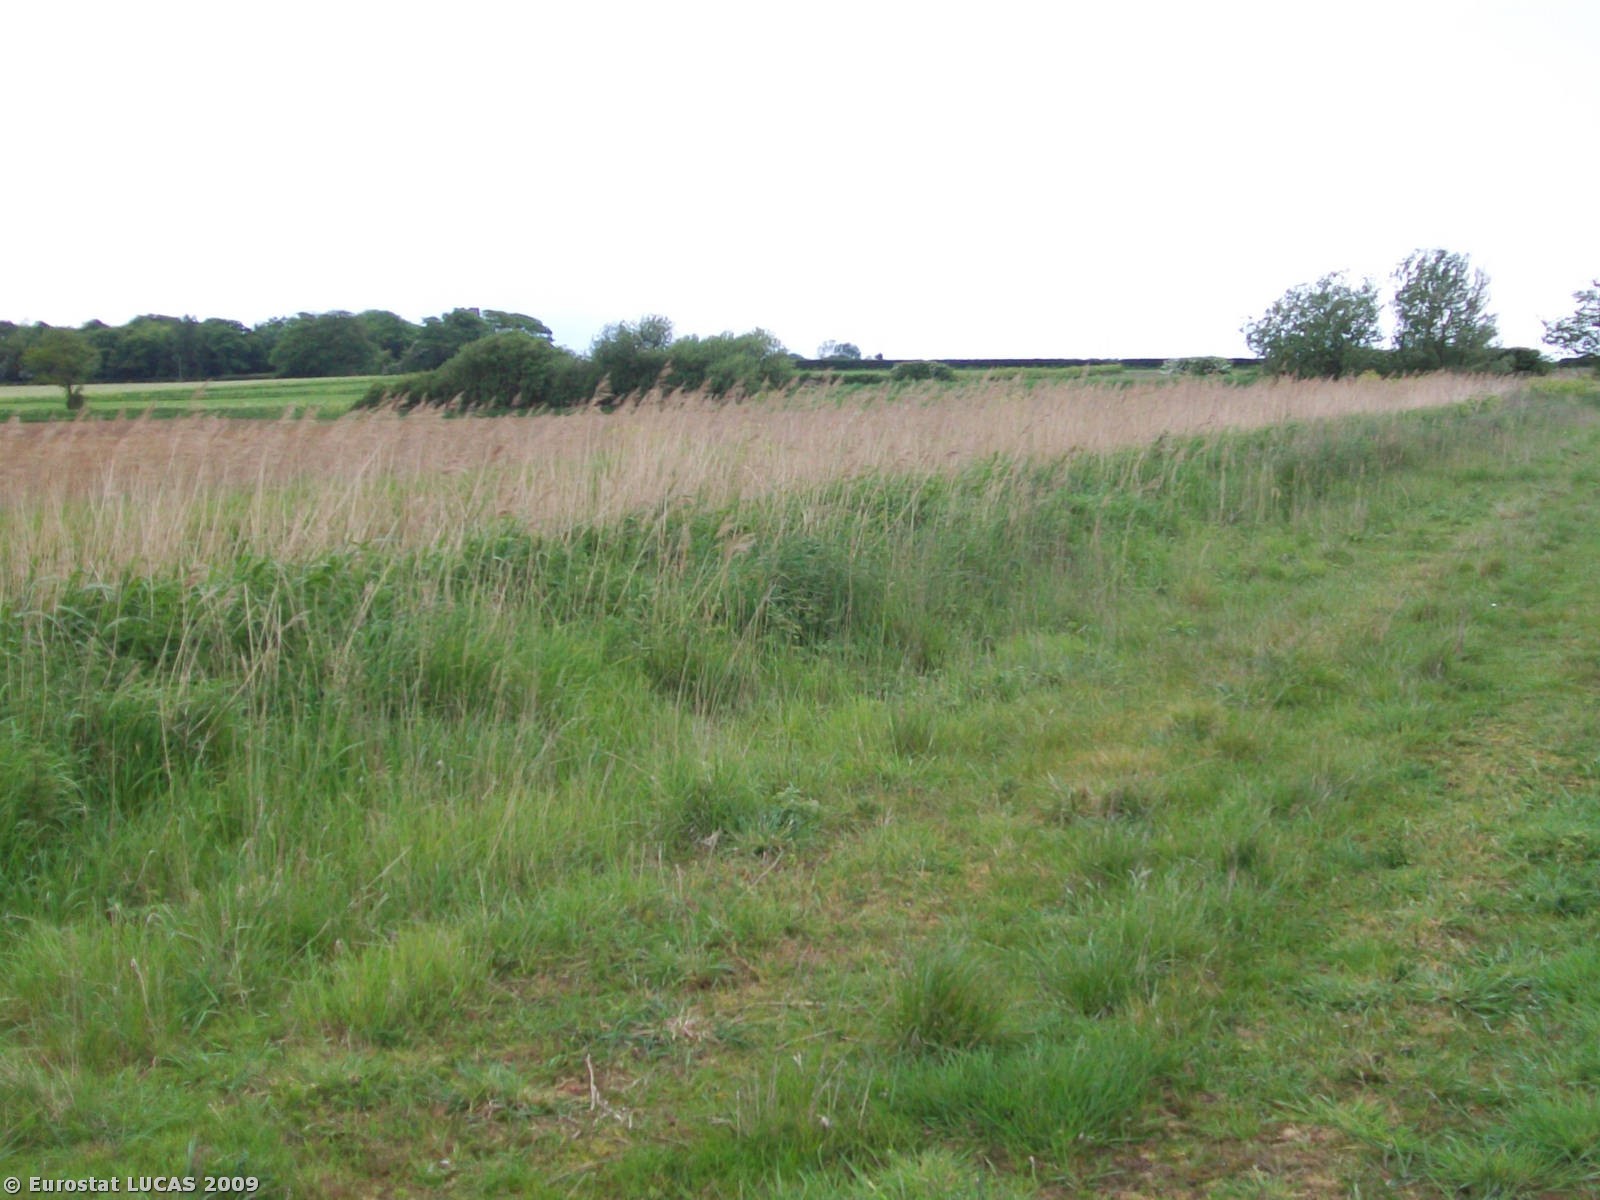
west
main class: Cropland
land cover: Common wheat
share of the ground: 25 - 50 %
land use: Agriculture (excluding fallow land and kitchen gardens)
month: May
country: GB
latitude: 52.8005
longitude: 1.5718
